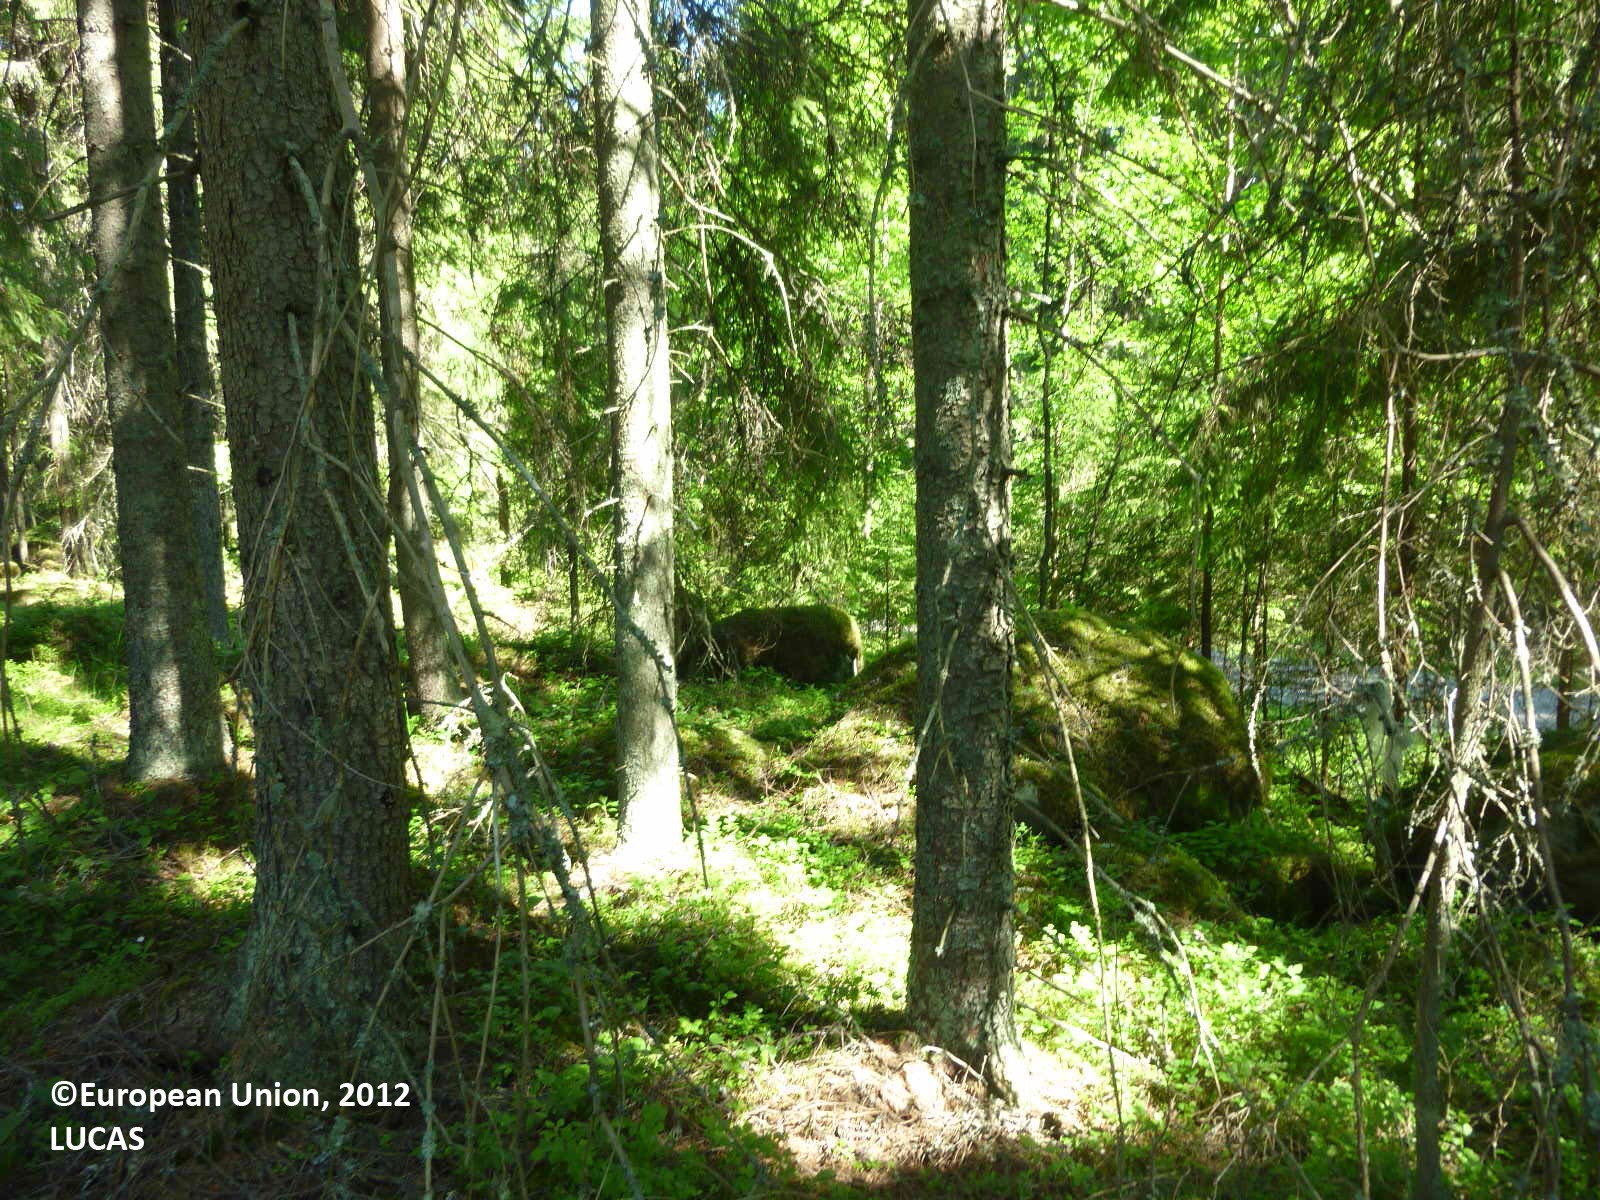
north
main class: Woodland
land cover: Spruce dominated coniferous woodland
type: boreal forest
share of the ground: > 75 %
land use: Forestry
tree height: > 5 m
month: June
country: FI
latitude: 61.4940
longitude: 22.8220
